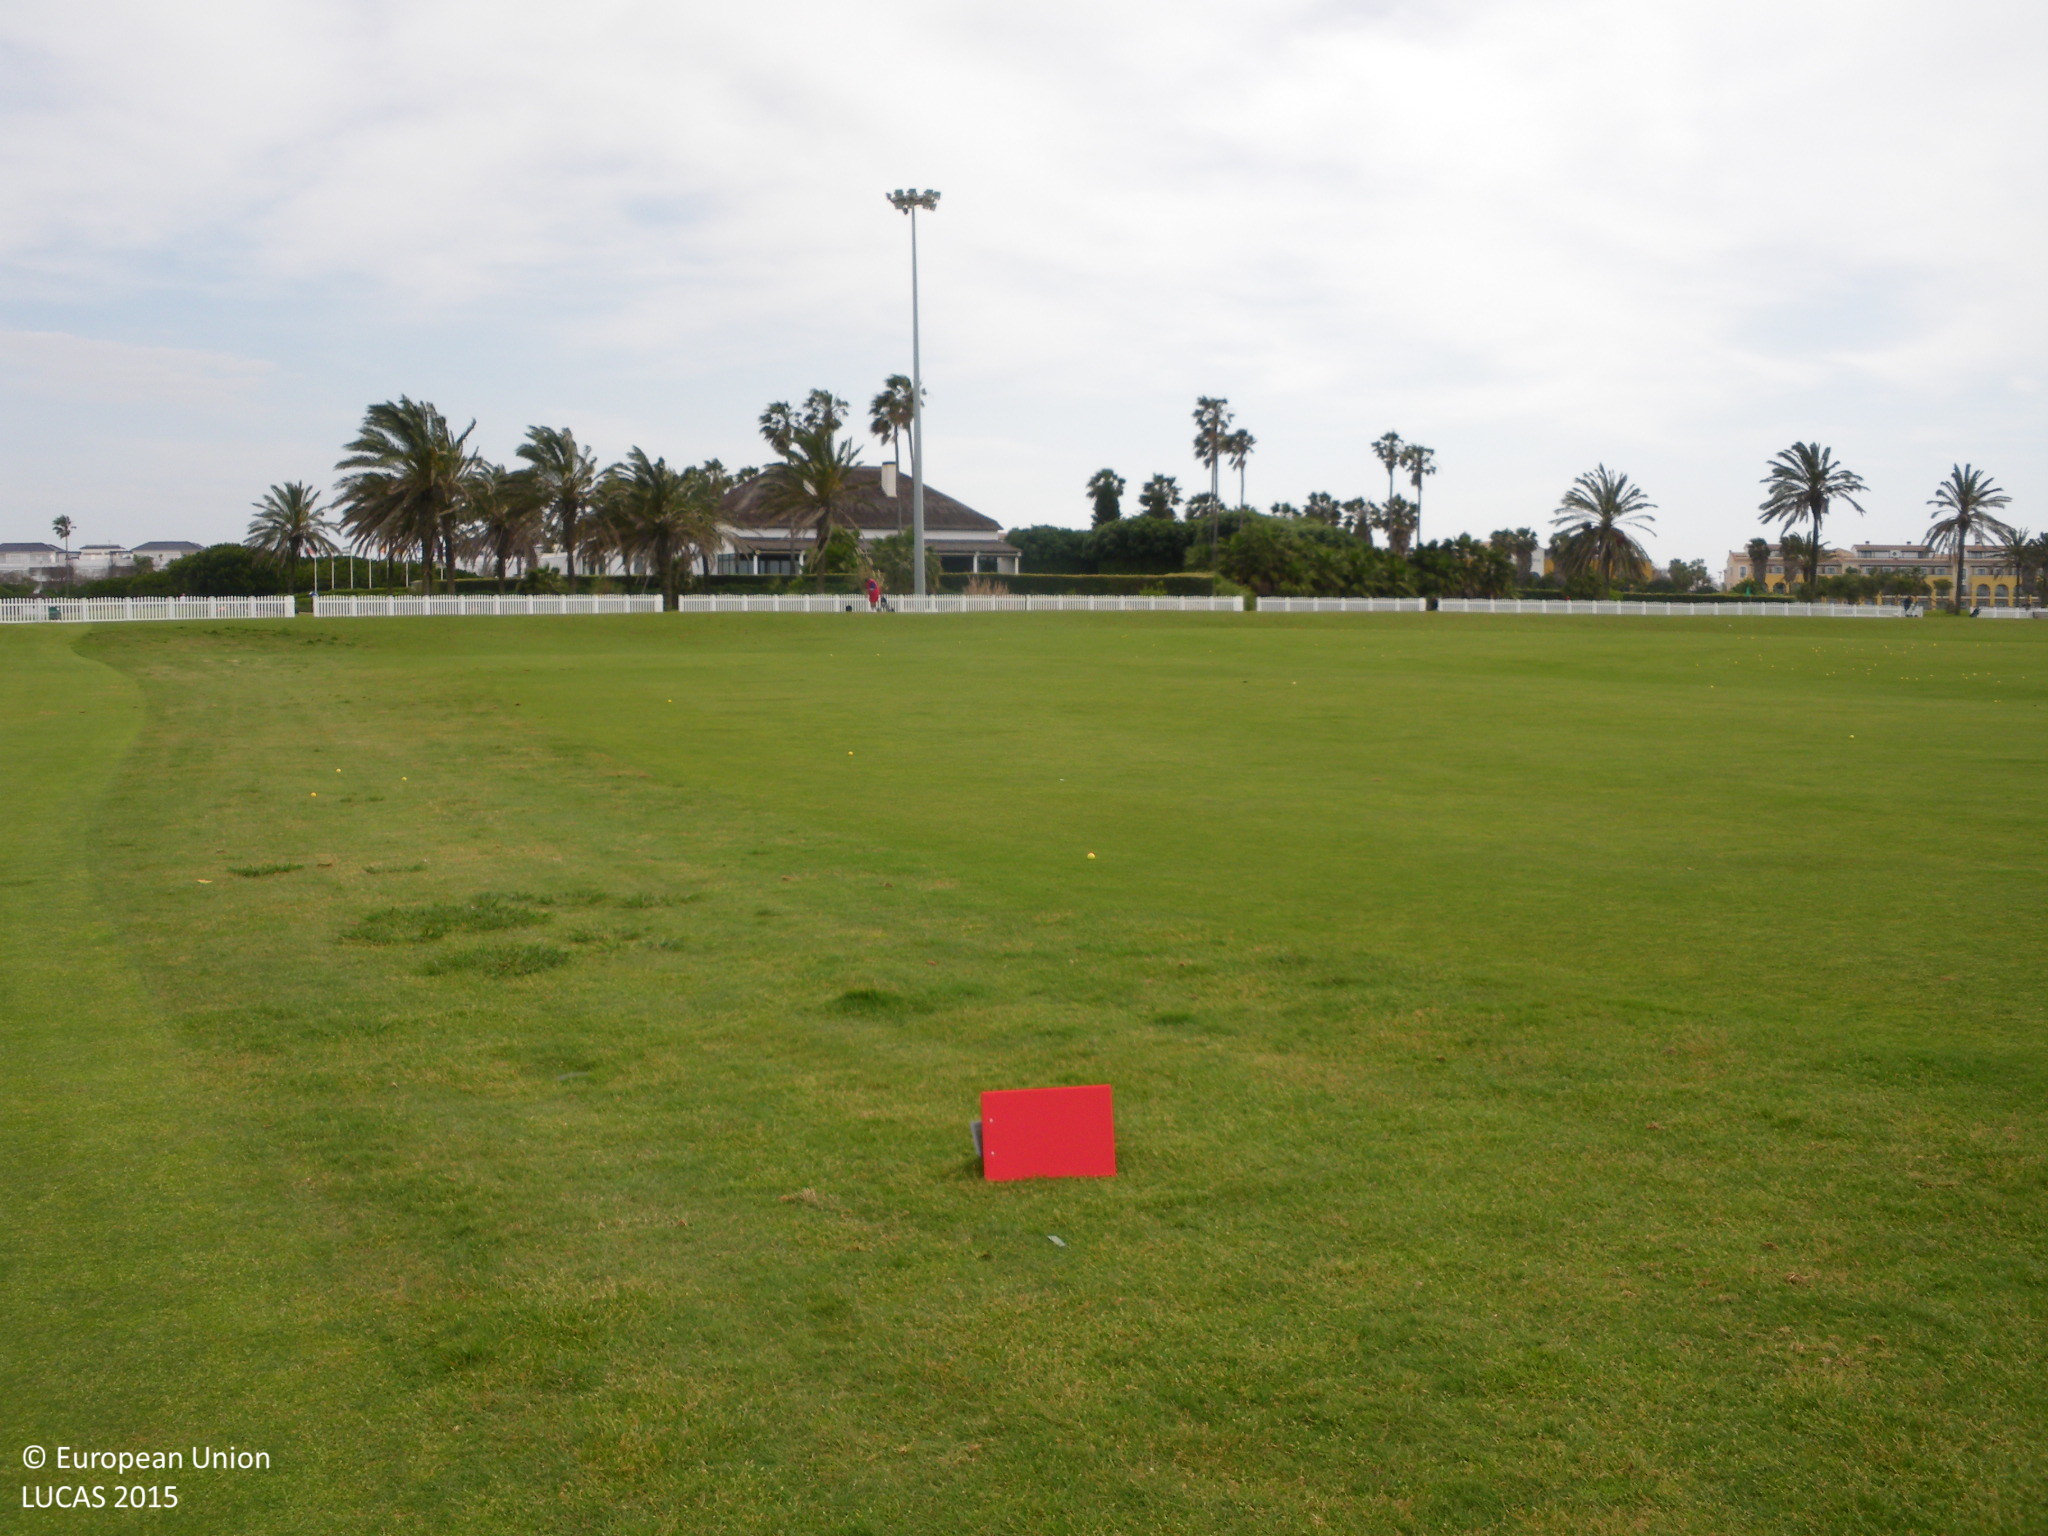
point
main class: Grassland
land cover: Grassland without tree/shrub cover
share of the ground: > 75 %
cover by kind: herbaceous plants 100 %
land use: Sport
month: April
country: ES
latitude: 36.6805
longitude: -6.4105
